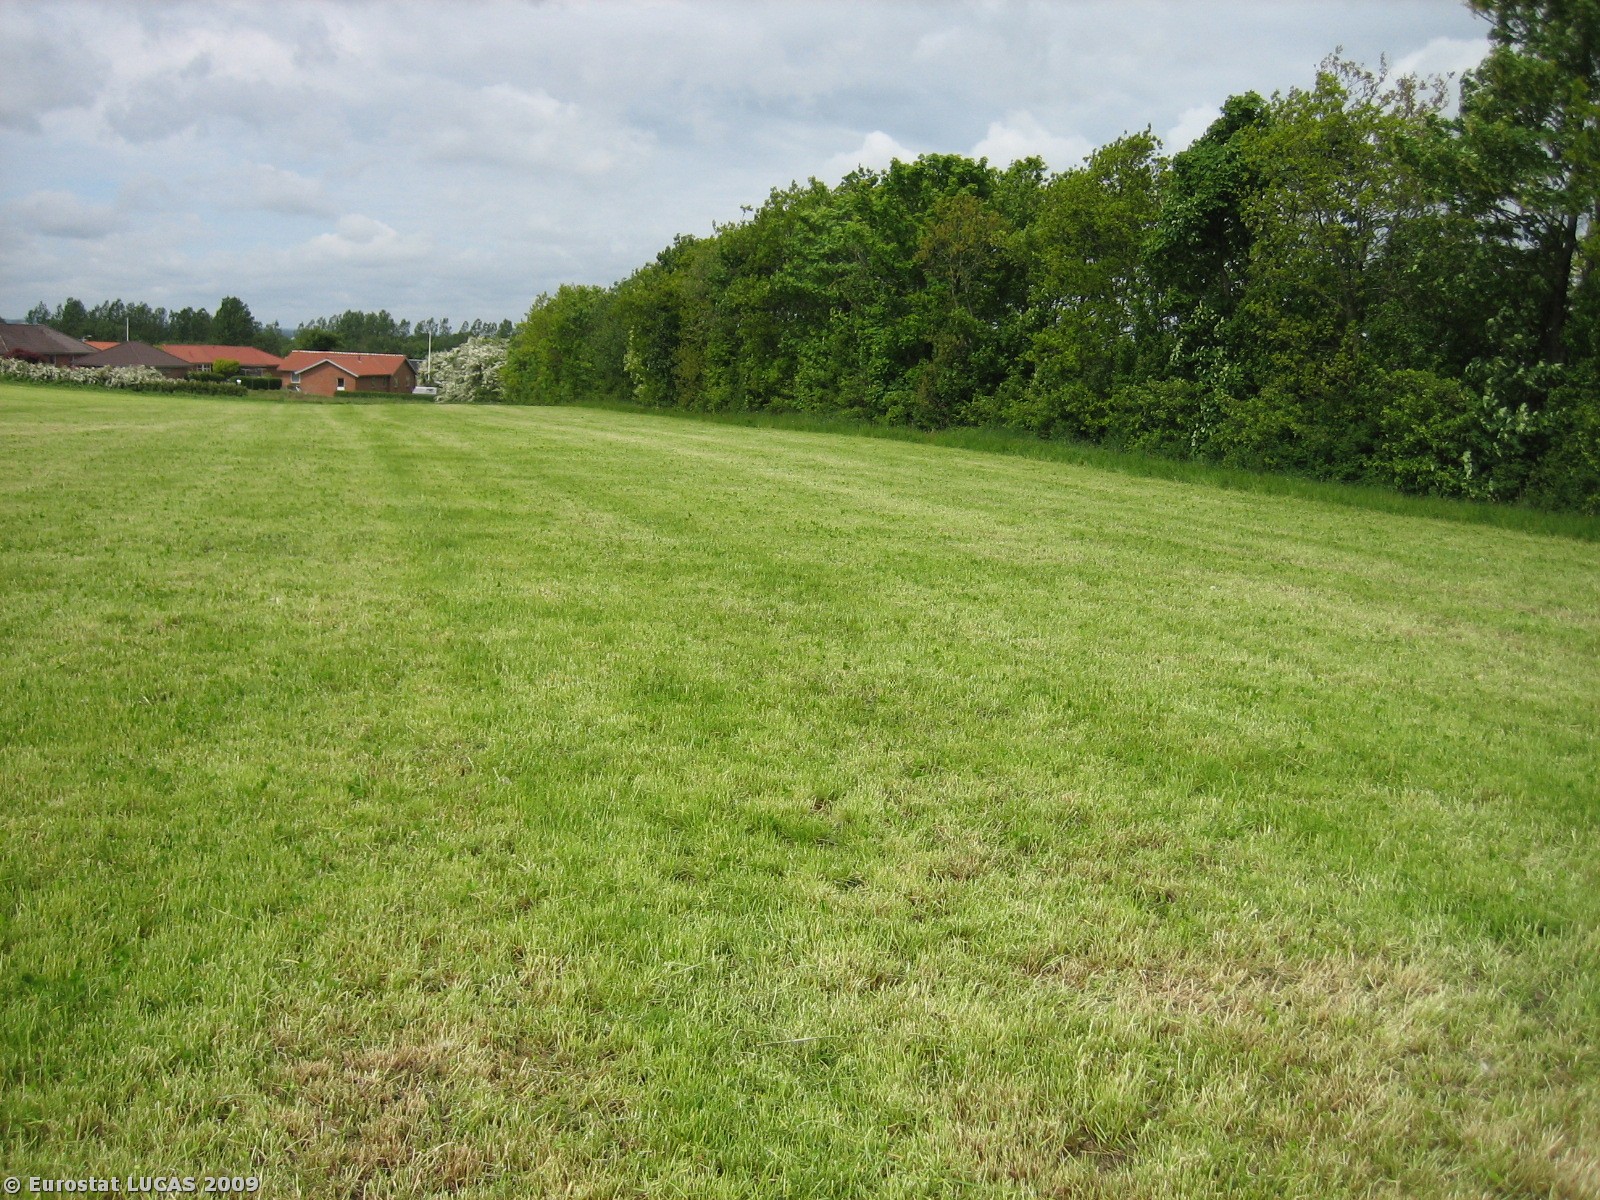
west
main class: Grassland
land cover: Grassland without tree/shrub cover
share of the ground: > 75 %
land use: Agriculture (excluding fallow land and kitchen gardens)
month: May
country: DK
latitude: 56.0745
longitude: 8.8285
